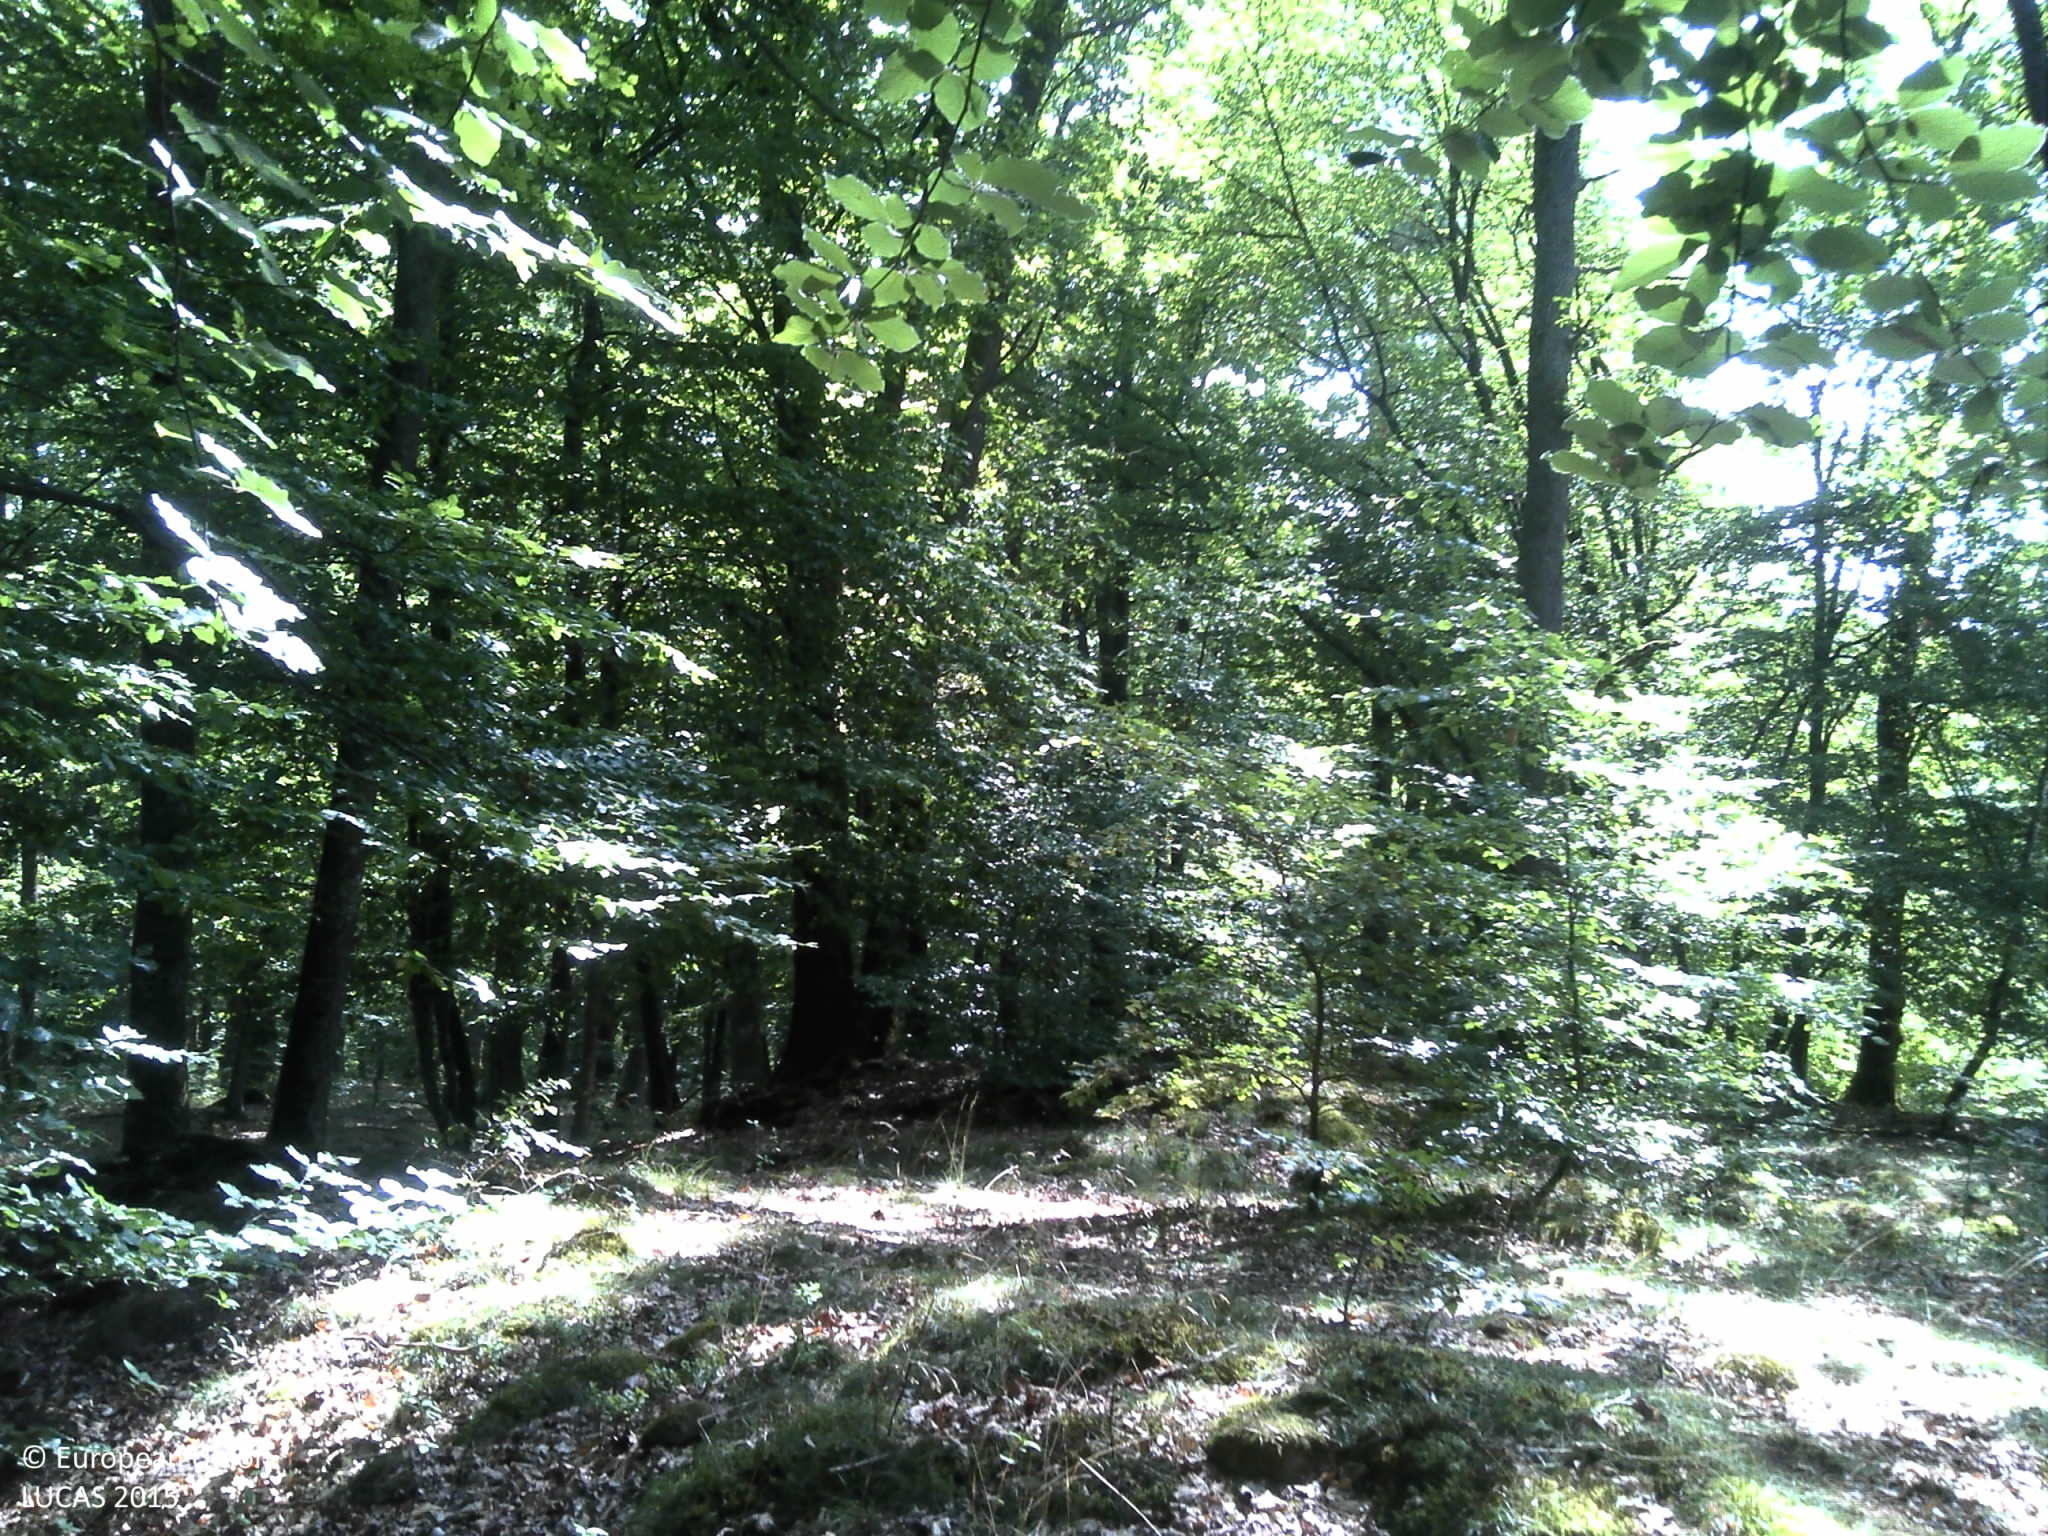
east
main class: Woodland
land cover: Broadleaved woodland
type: acidophilous oak and oak-birch forest
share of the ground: > 75 %
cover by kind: broadleaved forest trees 90 %, lichens and mosses 10 %
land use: Forestry
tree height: > 5 m
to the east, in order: Broadleaved woodland; Tracks; Broadleaved woodland; Fences; Groves; Grassland without tree/shrub cover; Inland fresh water bodies; Grassland without tree/shrub cover; Fences; Groves; Rock outcrops; Tracks; Rock outcrops; Broadleaved woodland
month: July
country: FR
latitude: 48.9699
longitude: 7.5280
